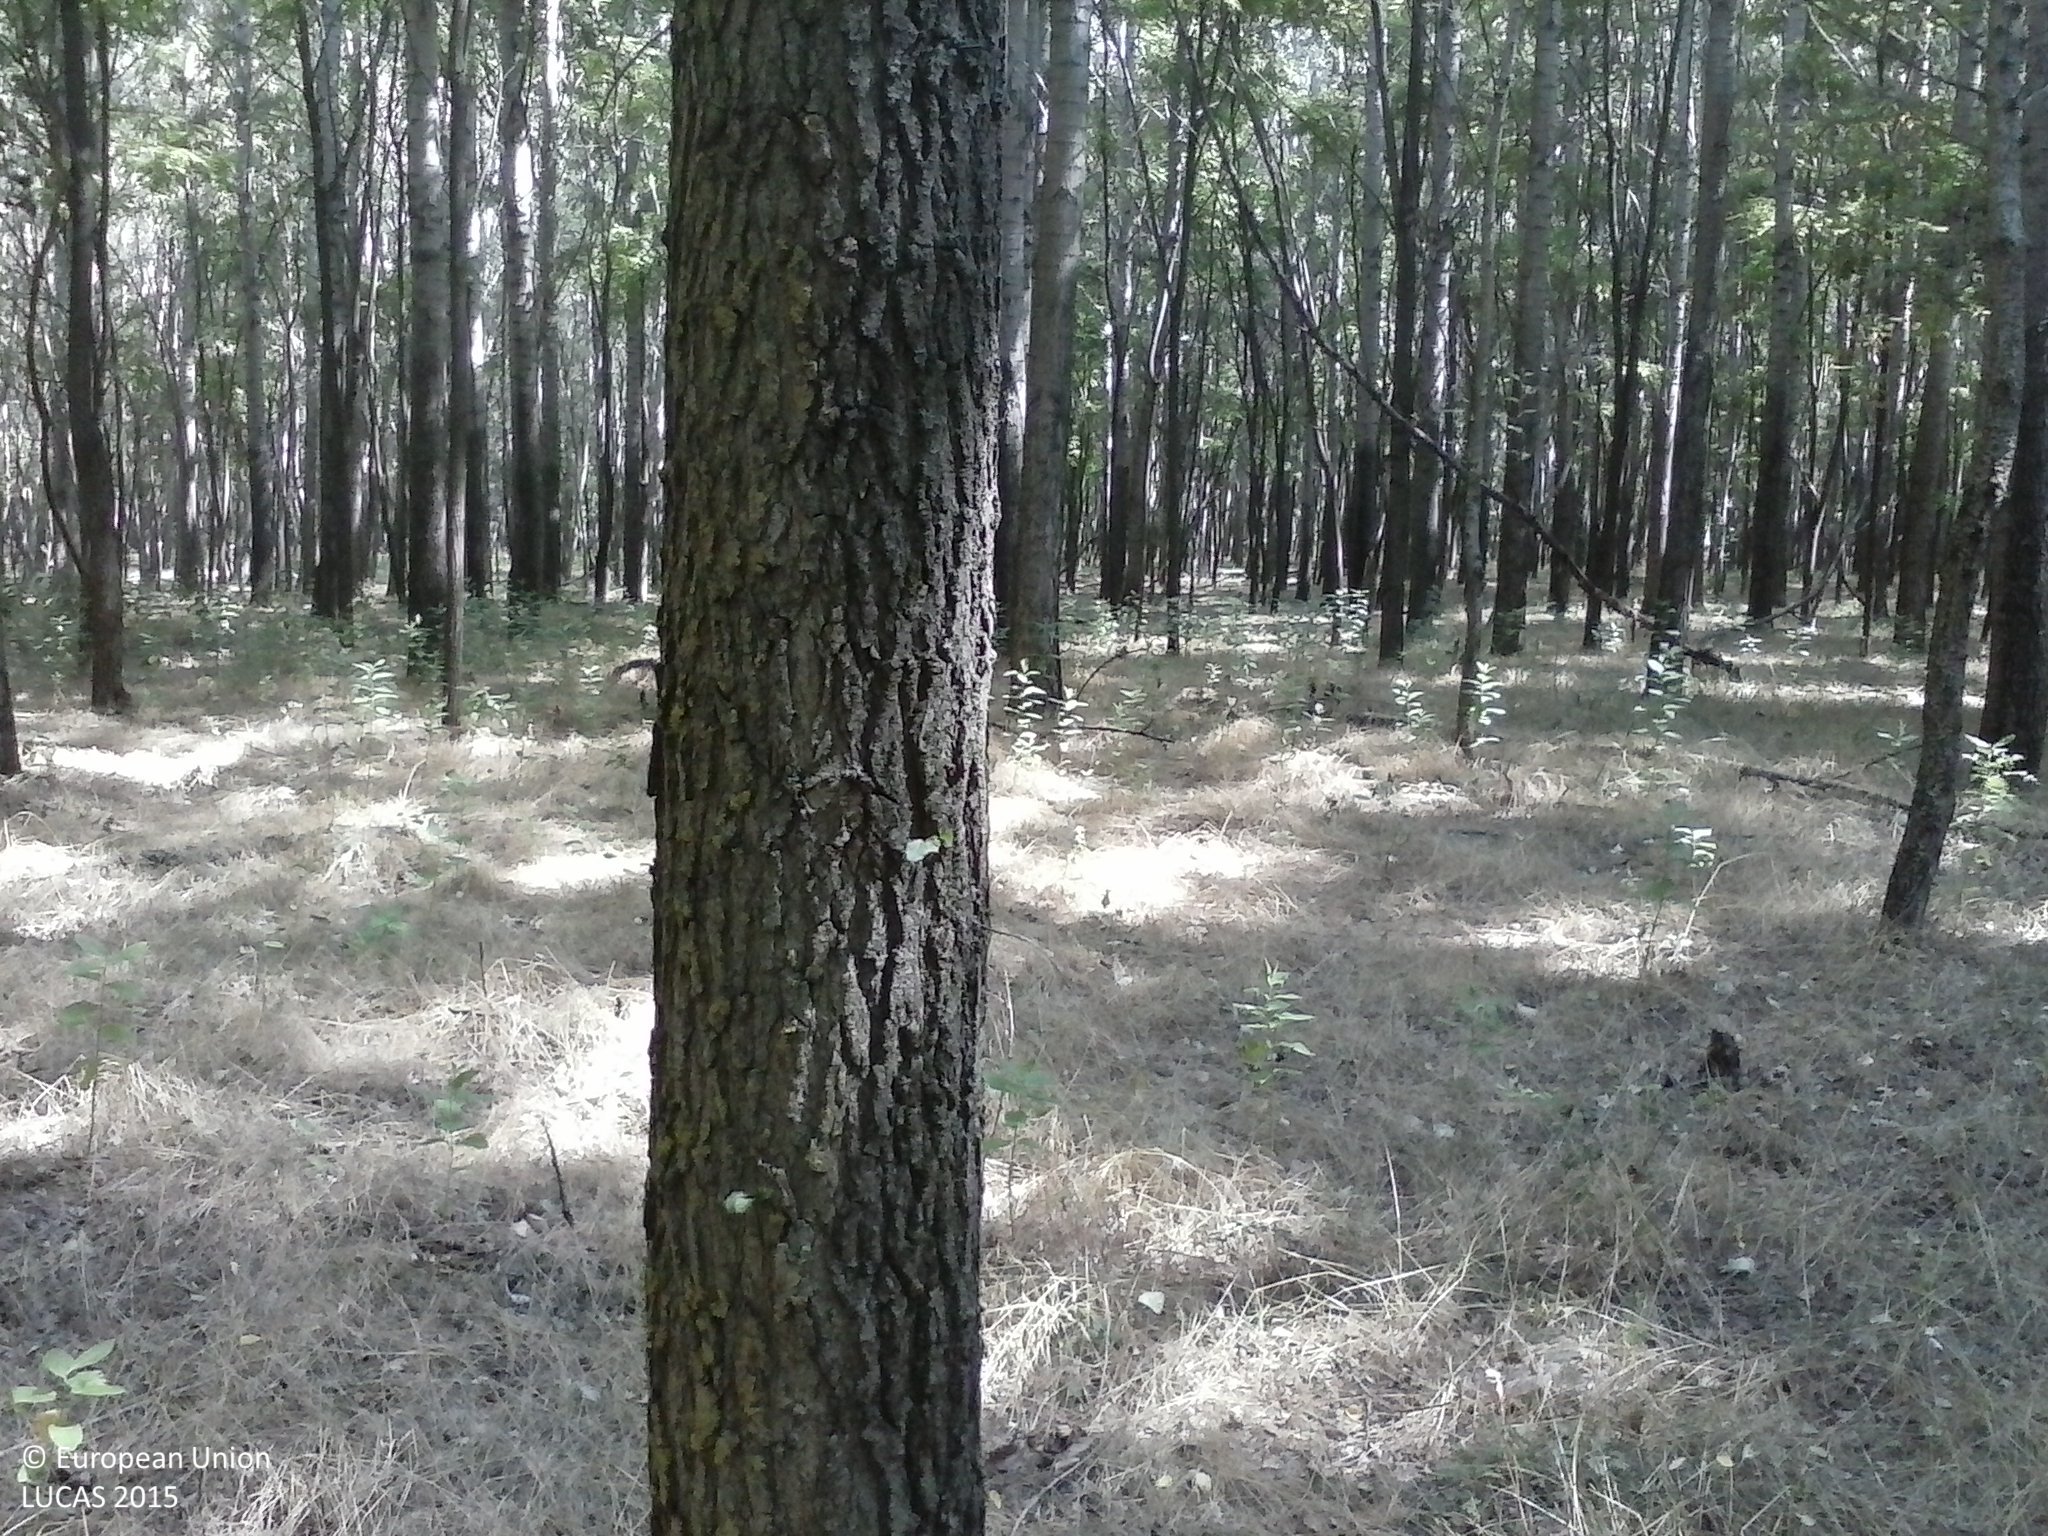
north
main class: Woodland
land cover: Broadleaved woodland
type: mesophytic deciduous forest
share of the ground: > 75 %
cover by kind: broadleaved forest trees 90 %, herbaceous plants 10 %
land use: Forestry
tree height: > 5 m
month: July
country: HU
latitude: 46.4945
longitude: 19.6470
